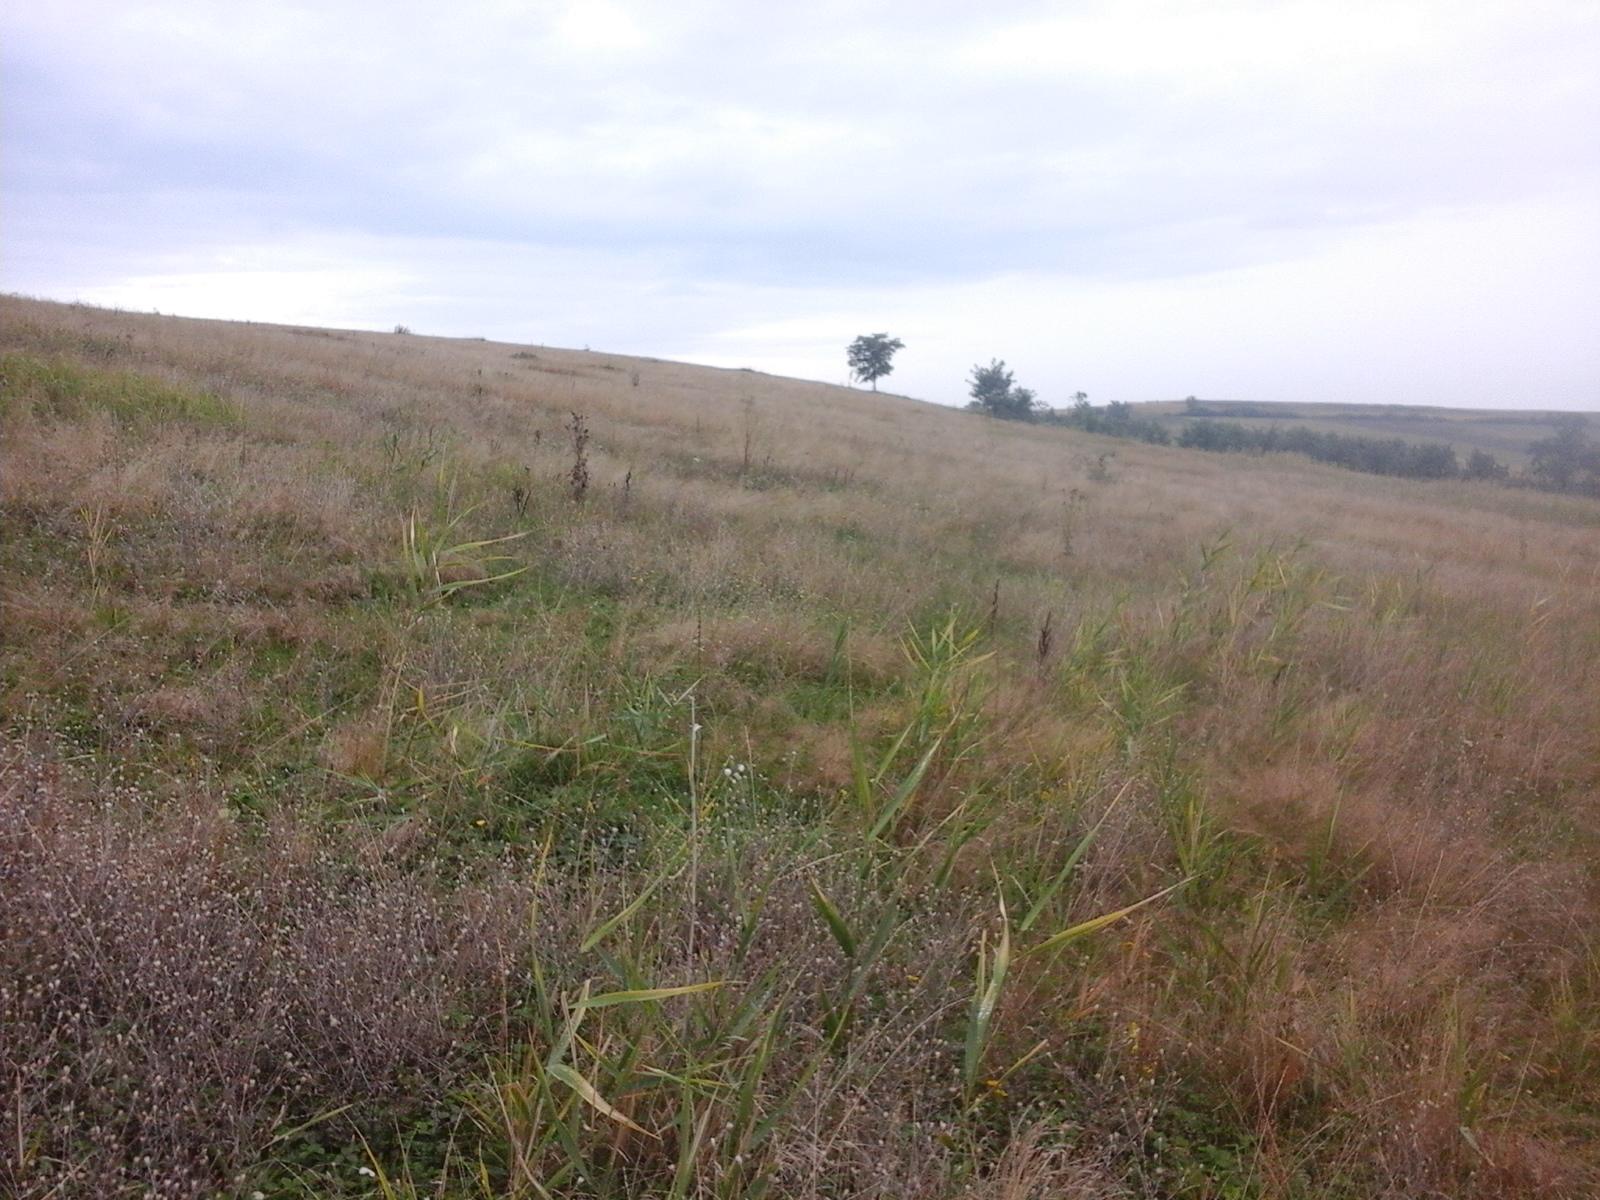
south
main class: Grassland
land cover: Grassland without tree/shrub cover
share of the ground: > 75 %
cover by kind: herbaceous plants 100 %
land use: Agriculture (excluding fallow land and kitchen gardens)
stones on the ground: < 10 %
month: September
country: RO
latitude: 47.2752
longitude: 22.6291
